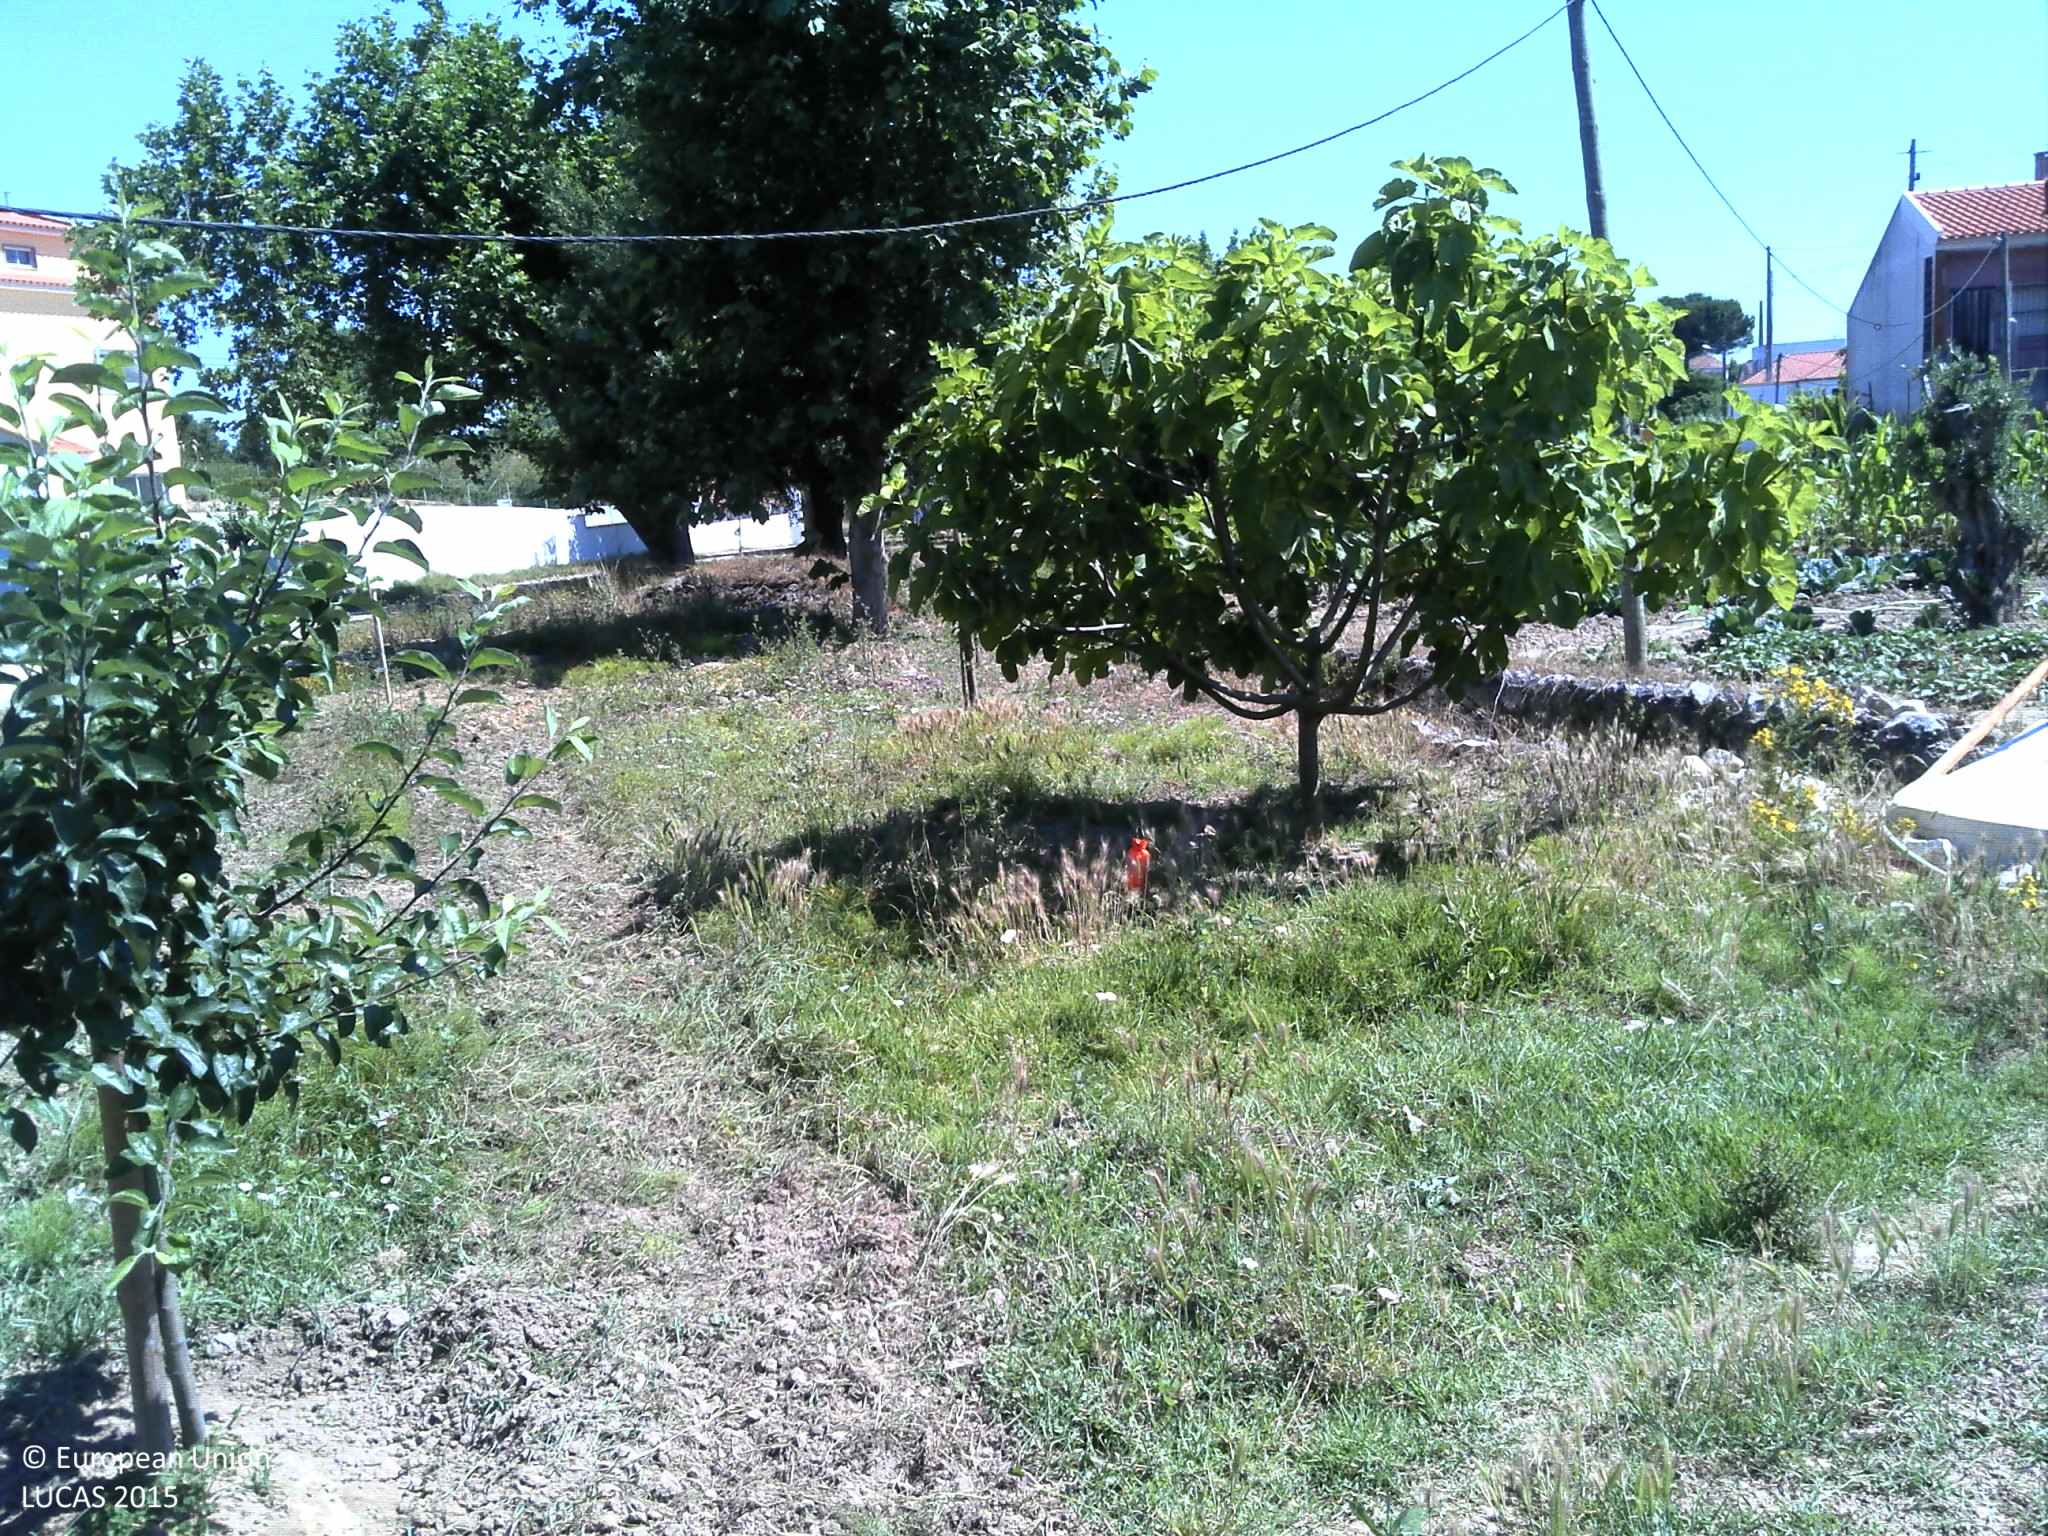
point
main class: Cropland
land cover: Other fruit trees and berries
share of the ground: 25 - 50 %
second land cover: Grassland without tree/shrub cover
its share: 50 - 75 %
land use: Kitchen garden
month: June
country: PT
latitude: 39.1408
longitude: -9.2343
